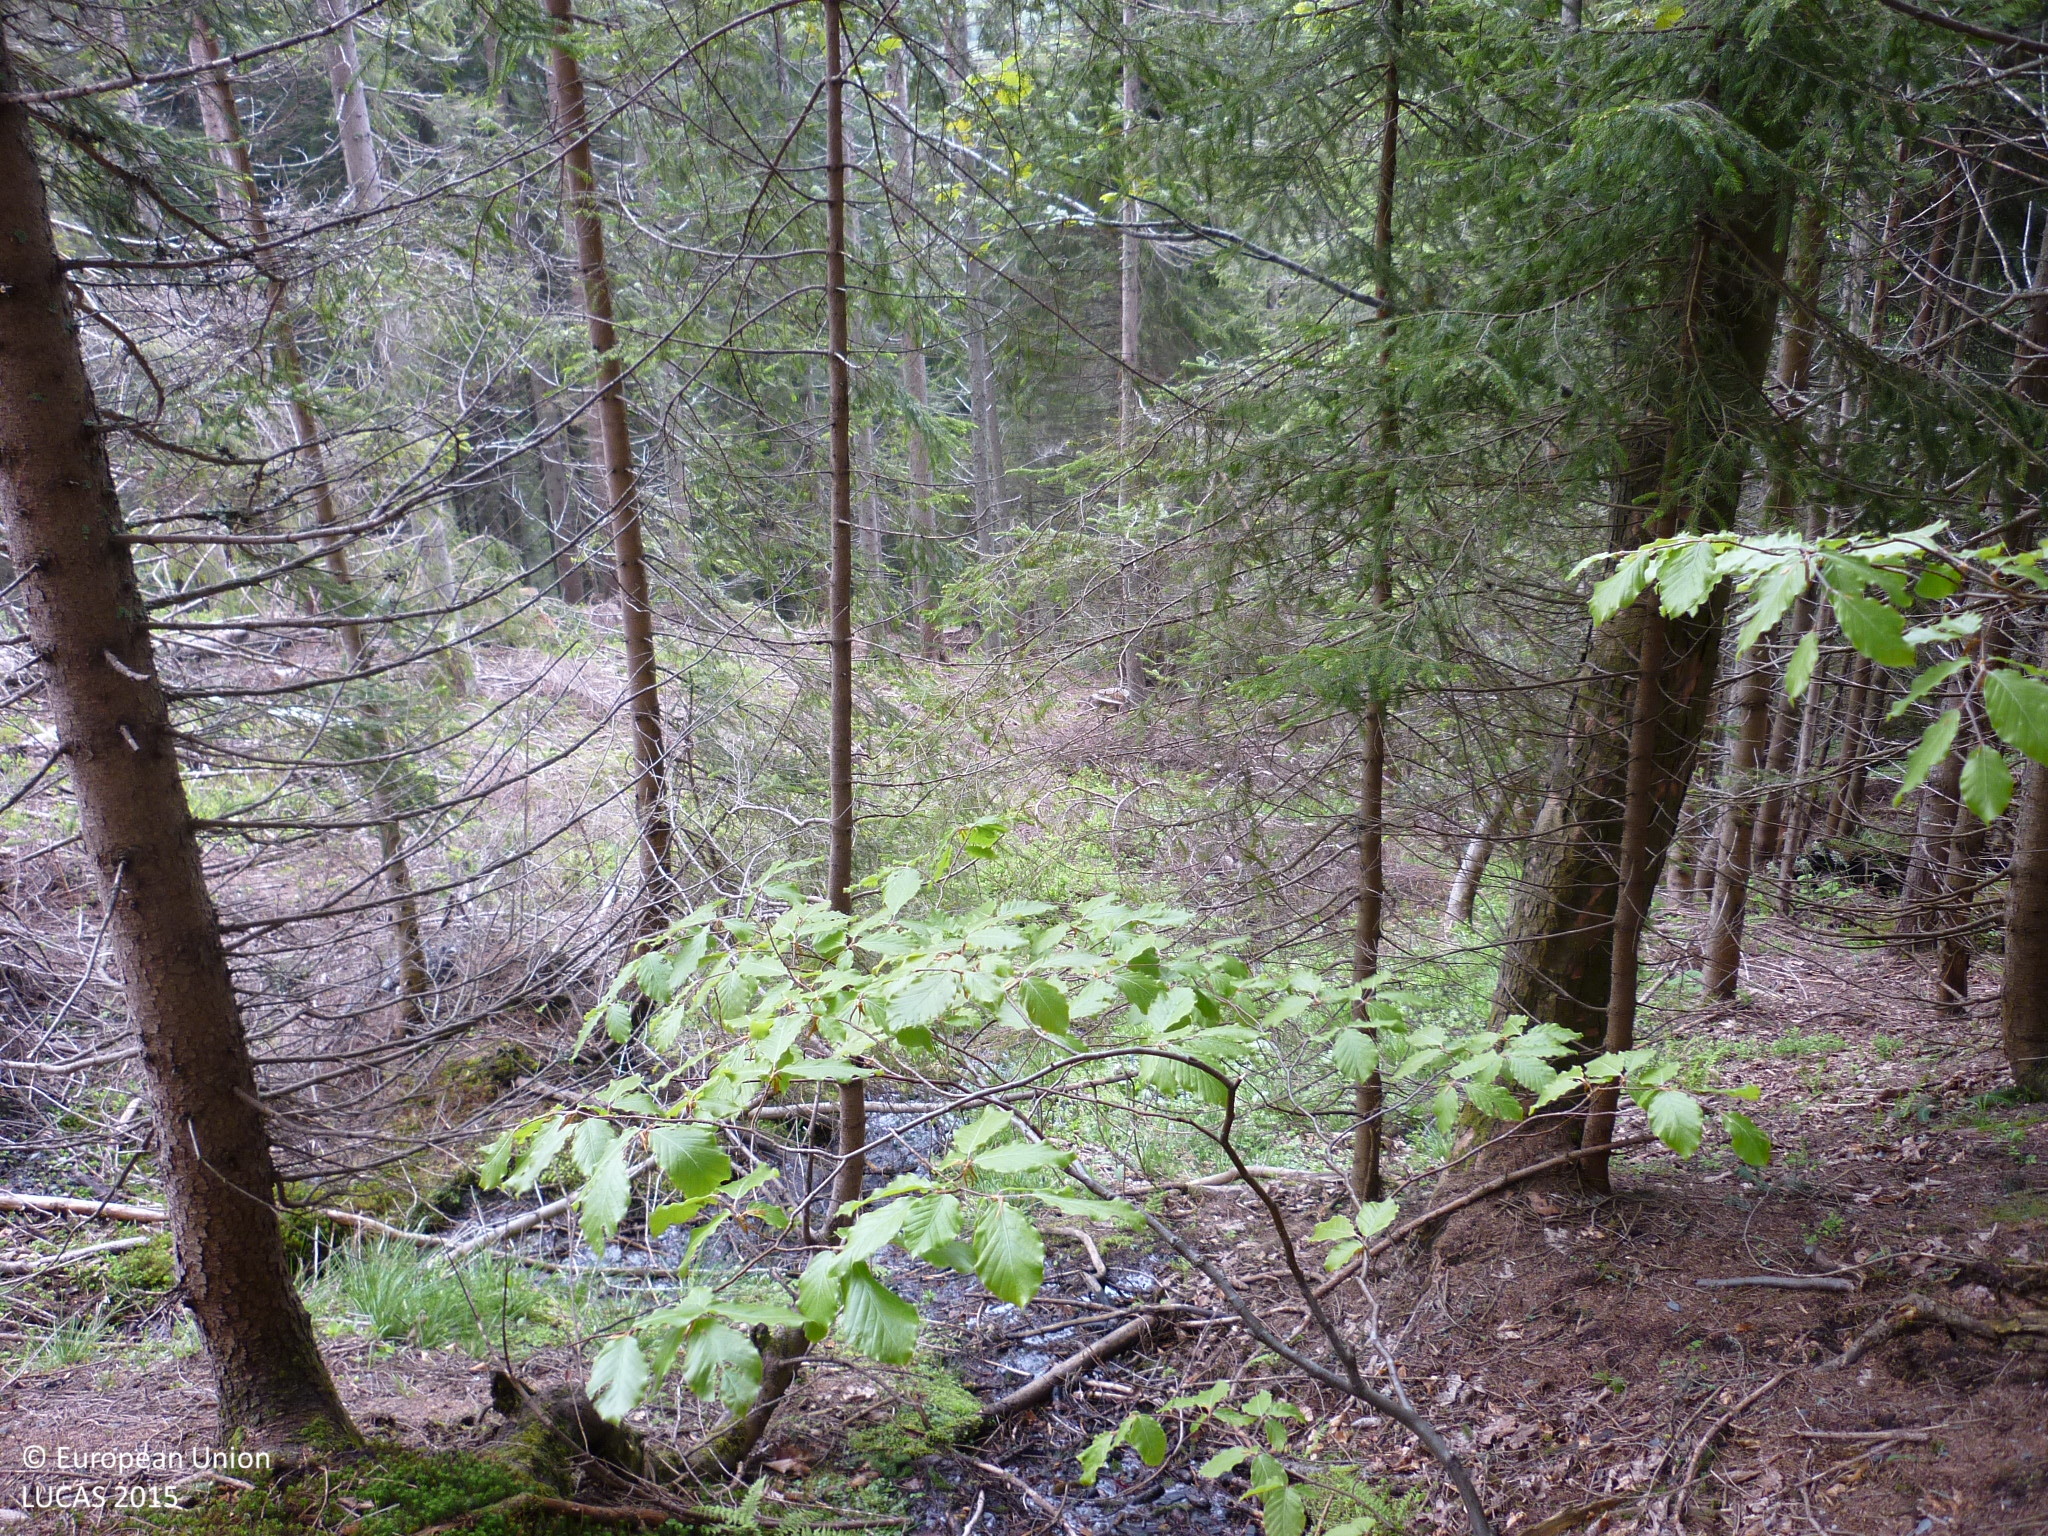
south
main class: Woodland
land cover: Spruce dominated coniferous woodland
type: alpine coniferous forest
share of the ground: > 75 %
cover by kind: coniferous forest trees 85 %, broadleaved forest trees 5 %, herbaceous plants 5 %, lichens and mosses 5 %
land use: Forestry
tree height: > 5 m
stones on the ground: 10 - 25 %
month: May
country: AT
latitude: 47.4560
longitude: 14.7081
